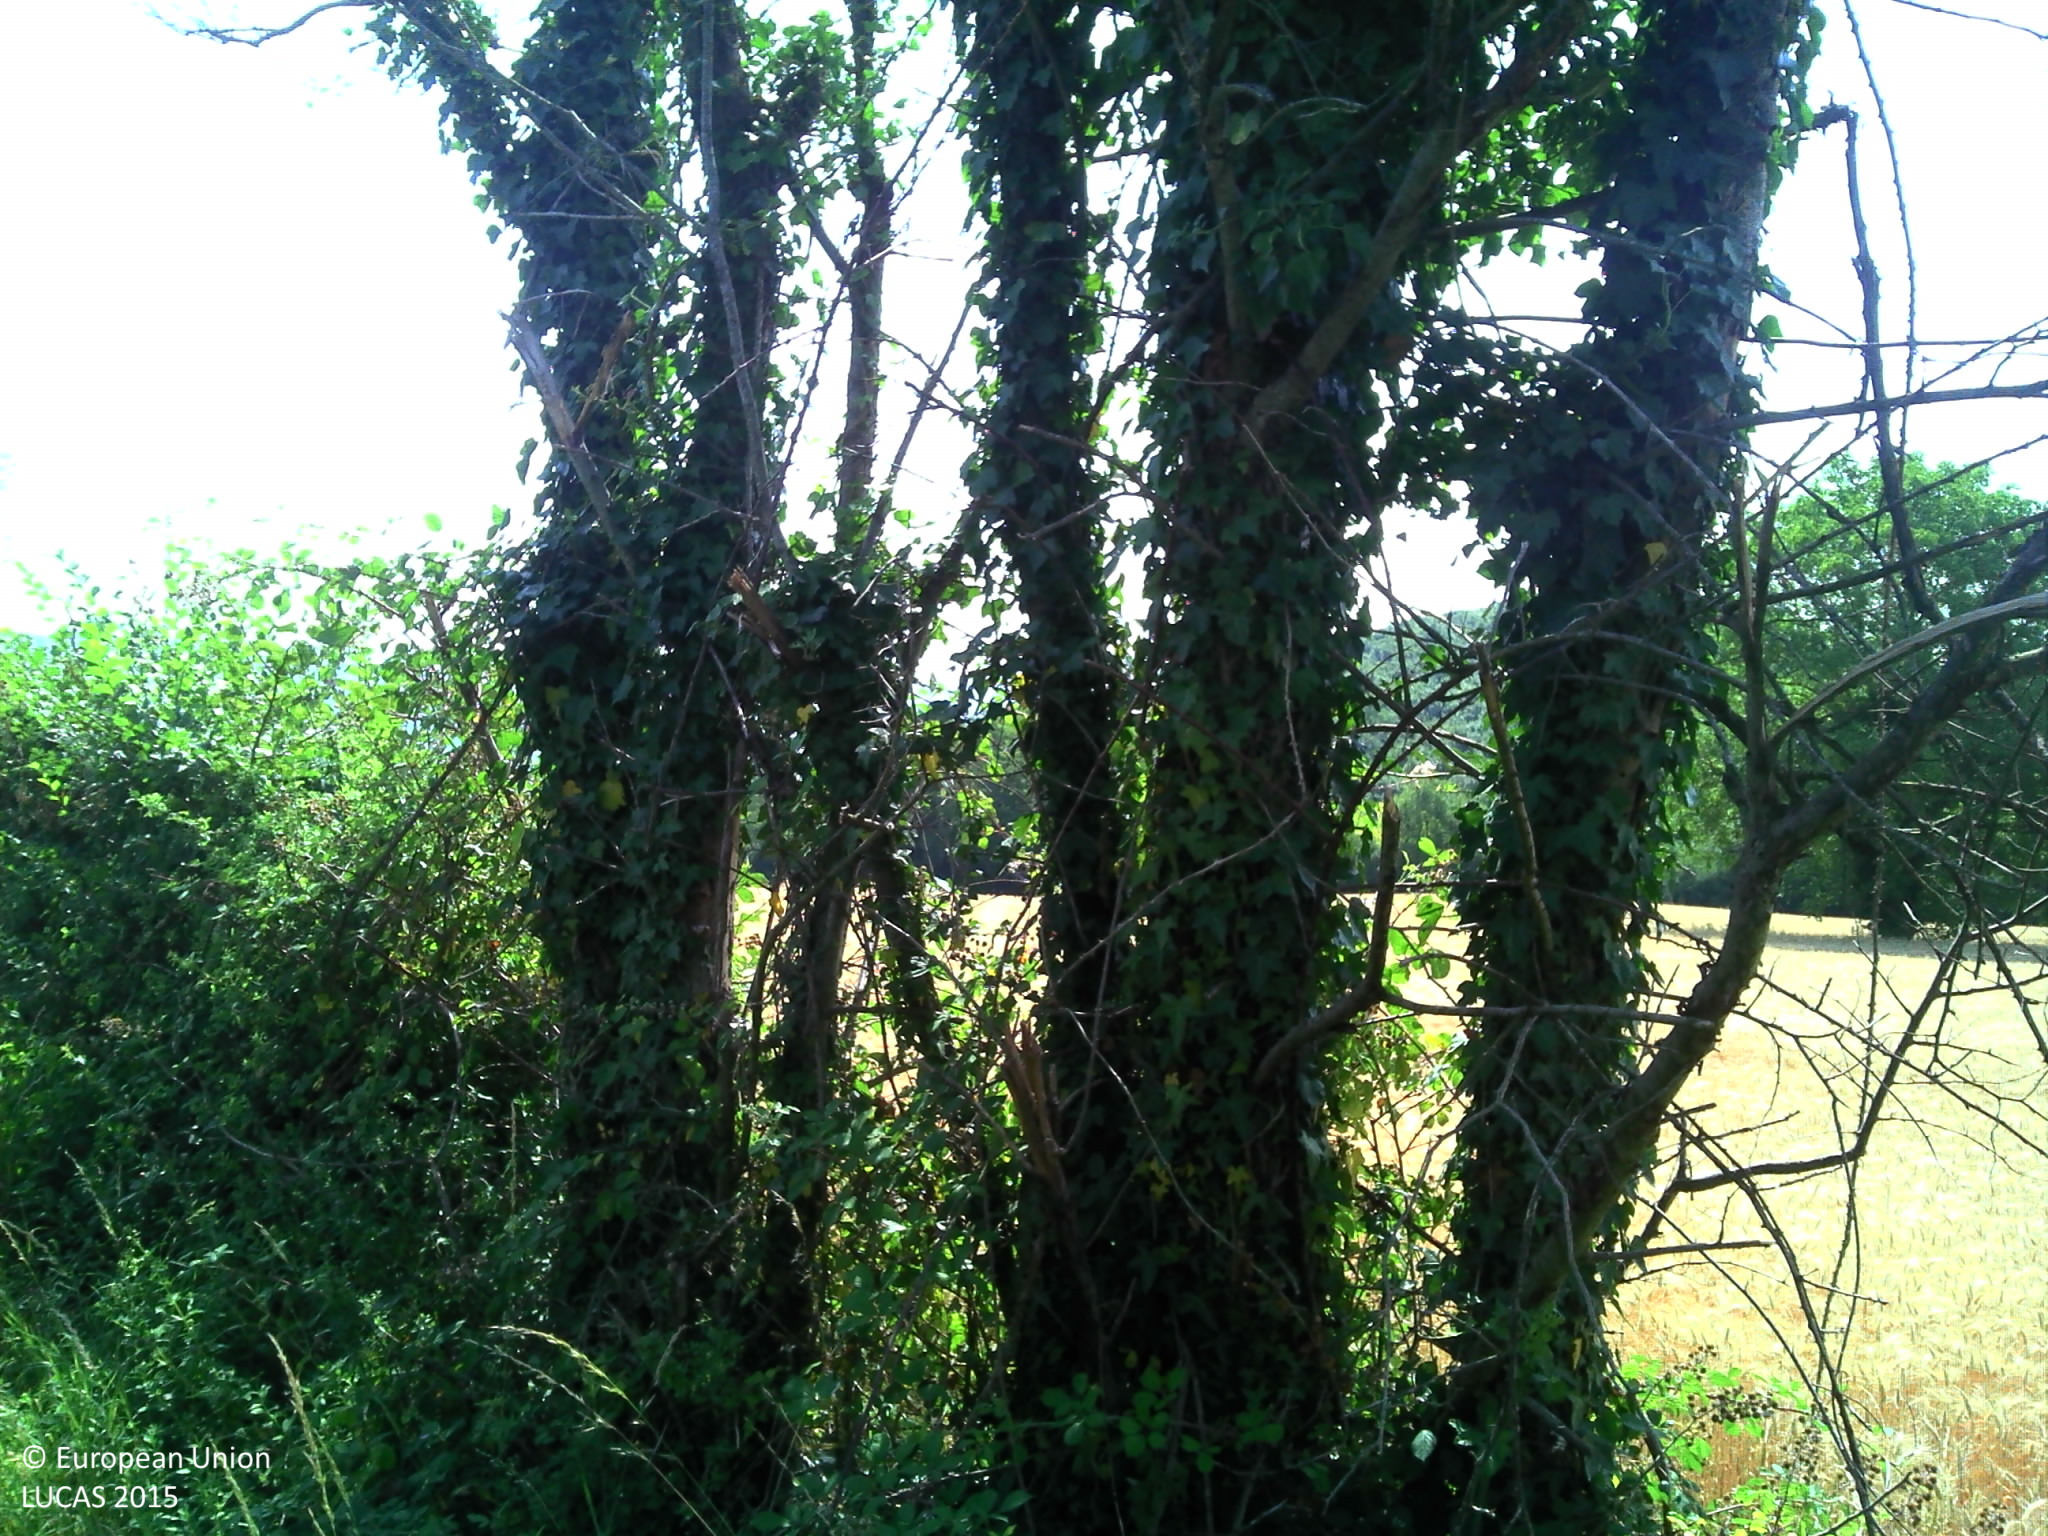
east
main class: Cropland
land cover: Durum wheat
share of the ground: > 75 %
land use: Agriculture (excluding fallow land and kitchen gardens)
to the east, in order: Durum wheat; Broadleaved woodland
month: July
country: FR
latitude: 45.7837
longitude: 5.4121
